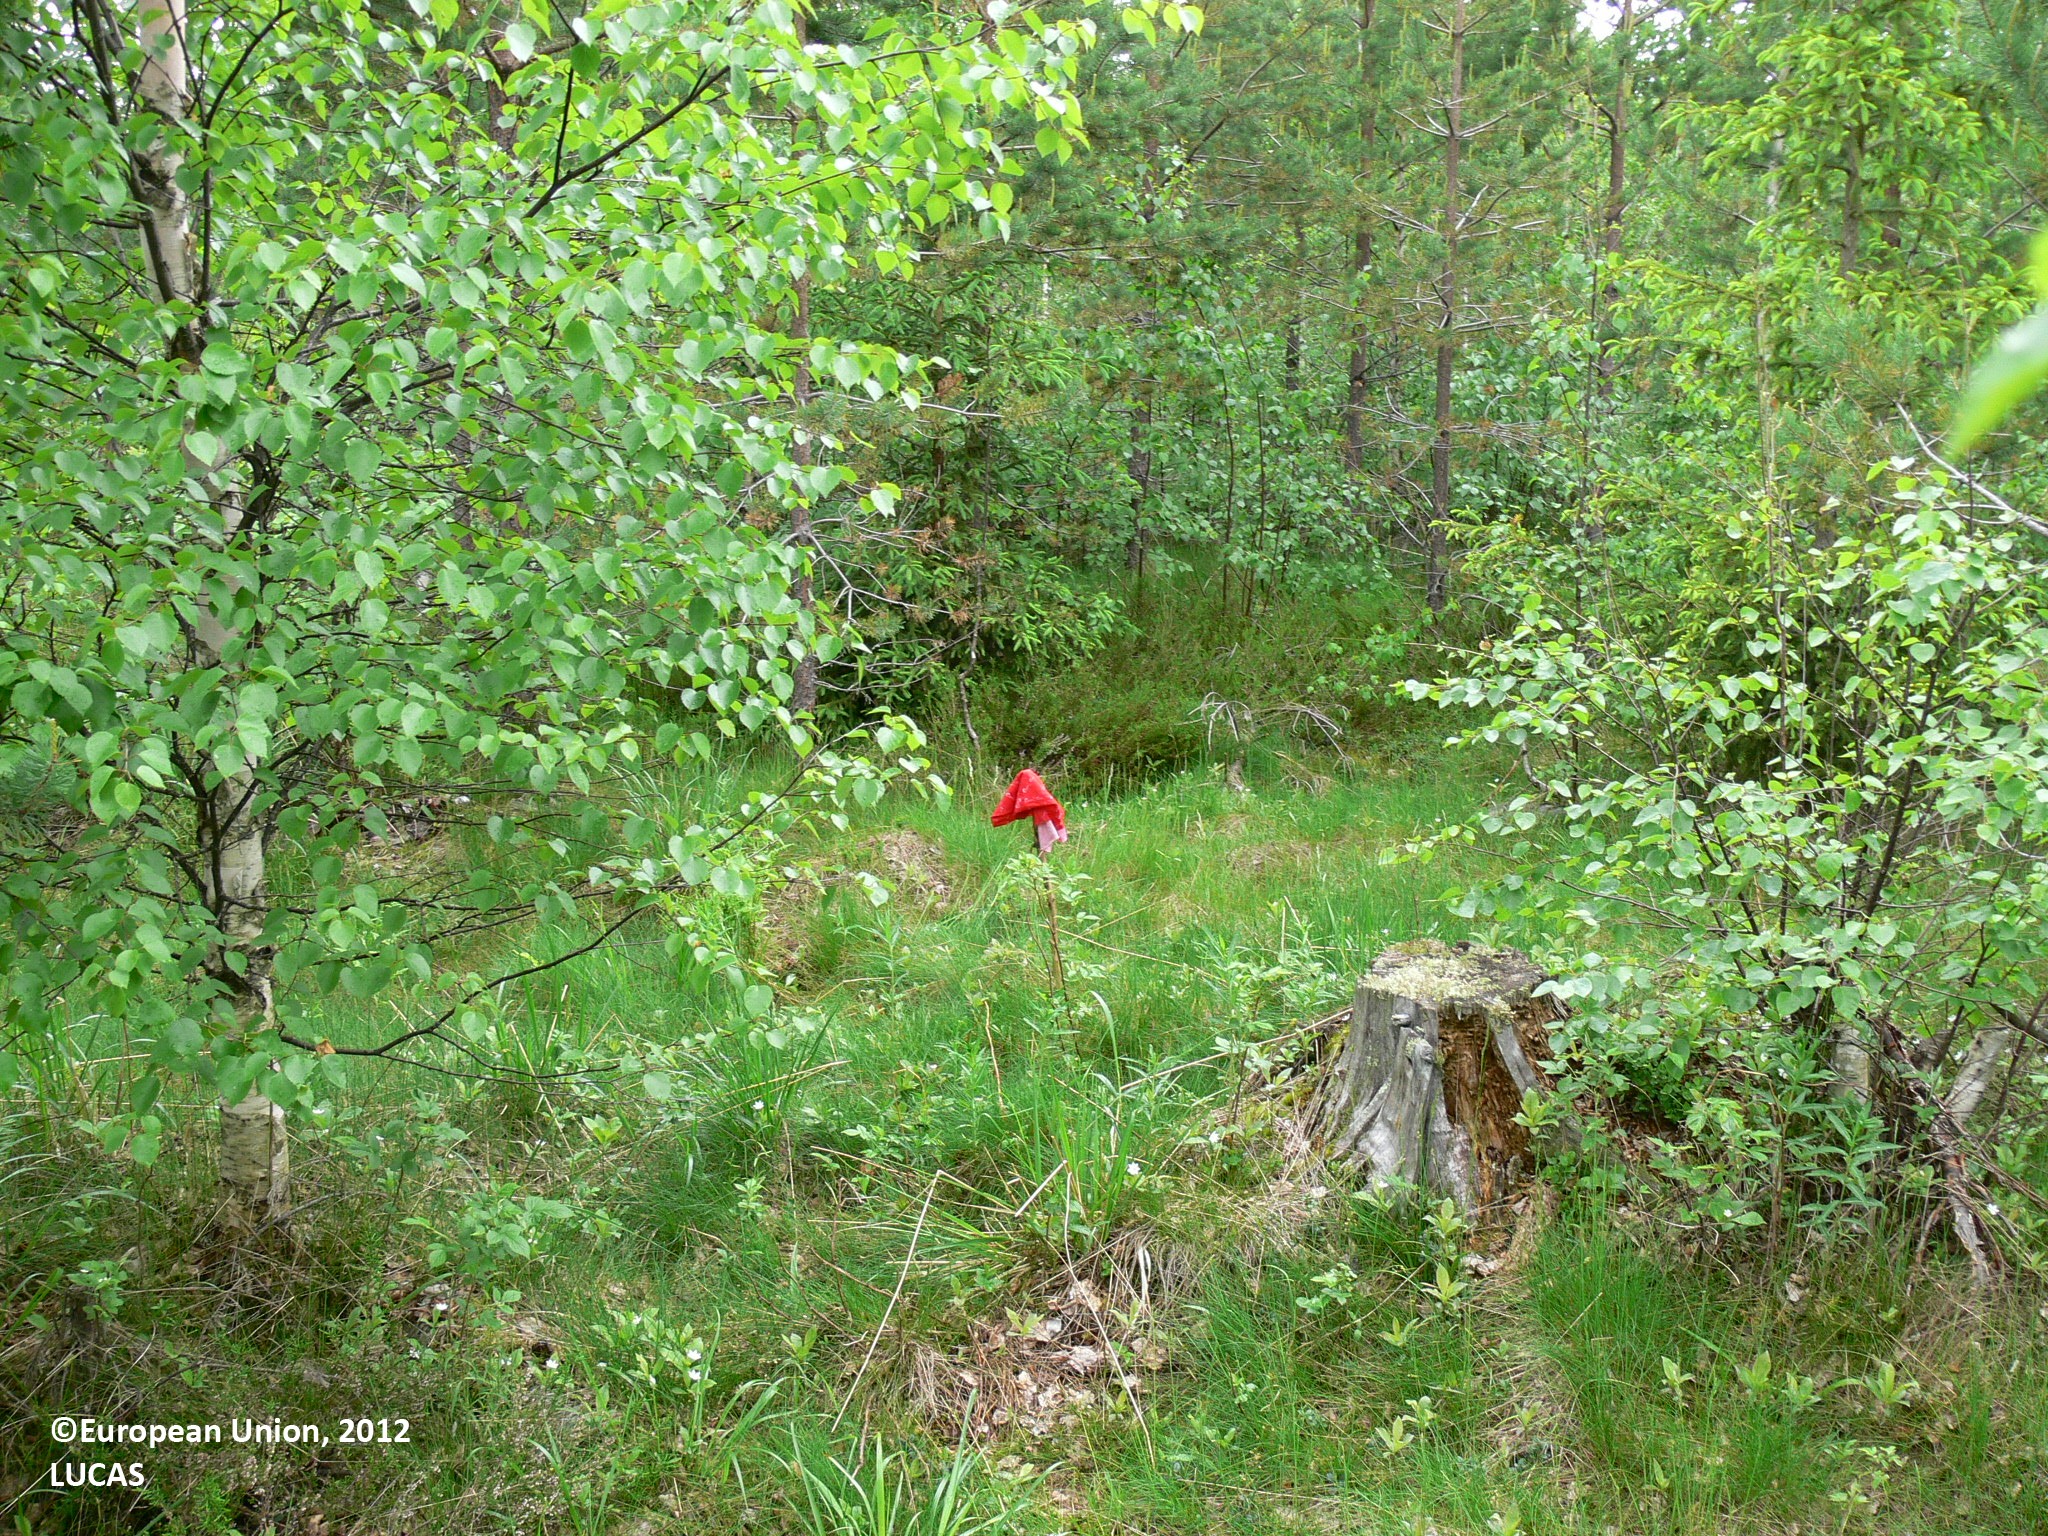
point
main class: Woodland
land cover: Other mixed woodland
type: boreal forest
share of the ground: > 75 %
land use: Forestry
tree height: < 5 m
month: June
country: FI
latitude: 62.9562
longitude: 29.8236
